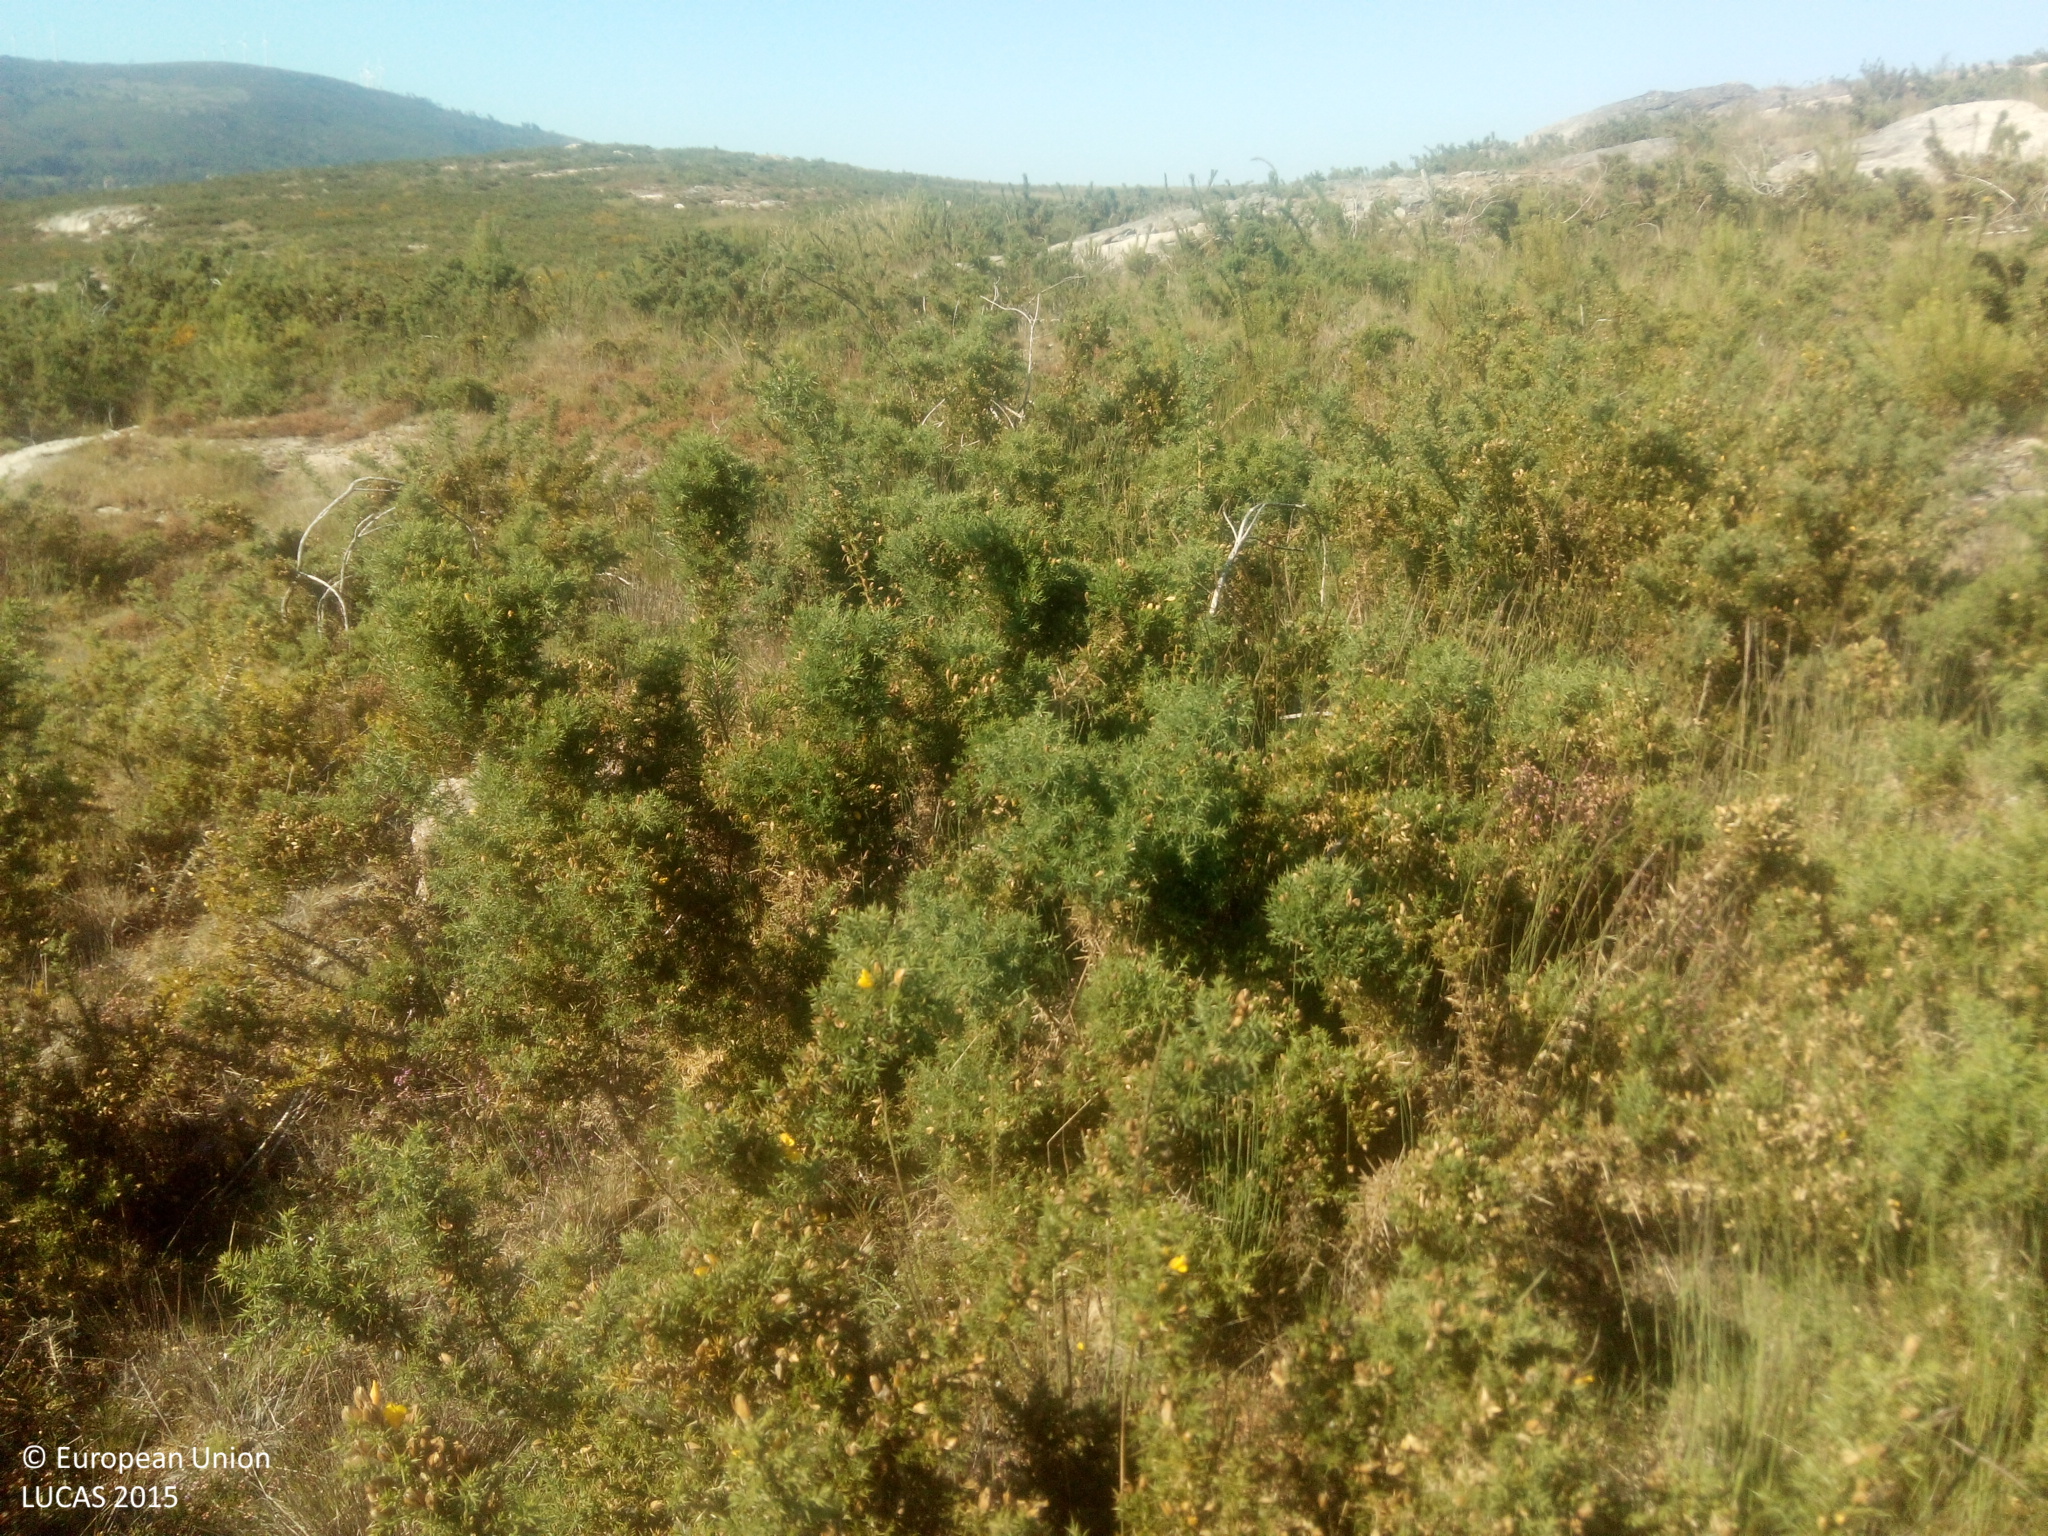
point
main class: Shrubland
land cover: Shrubland without tree cover
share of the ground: > 75 %
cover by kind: shrubs 100 %
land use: Semi-natural and natural areas not in use
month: June
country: ES
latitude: 42.1956
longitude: -8.2637
